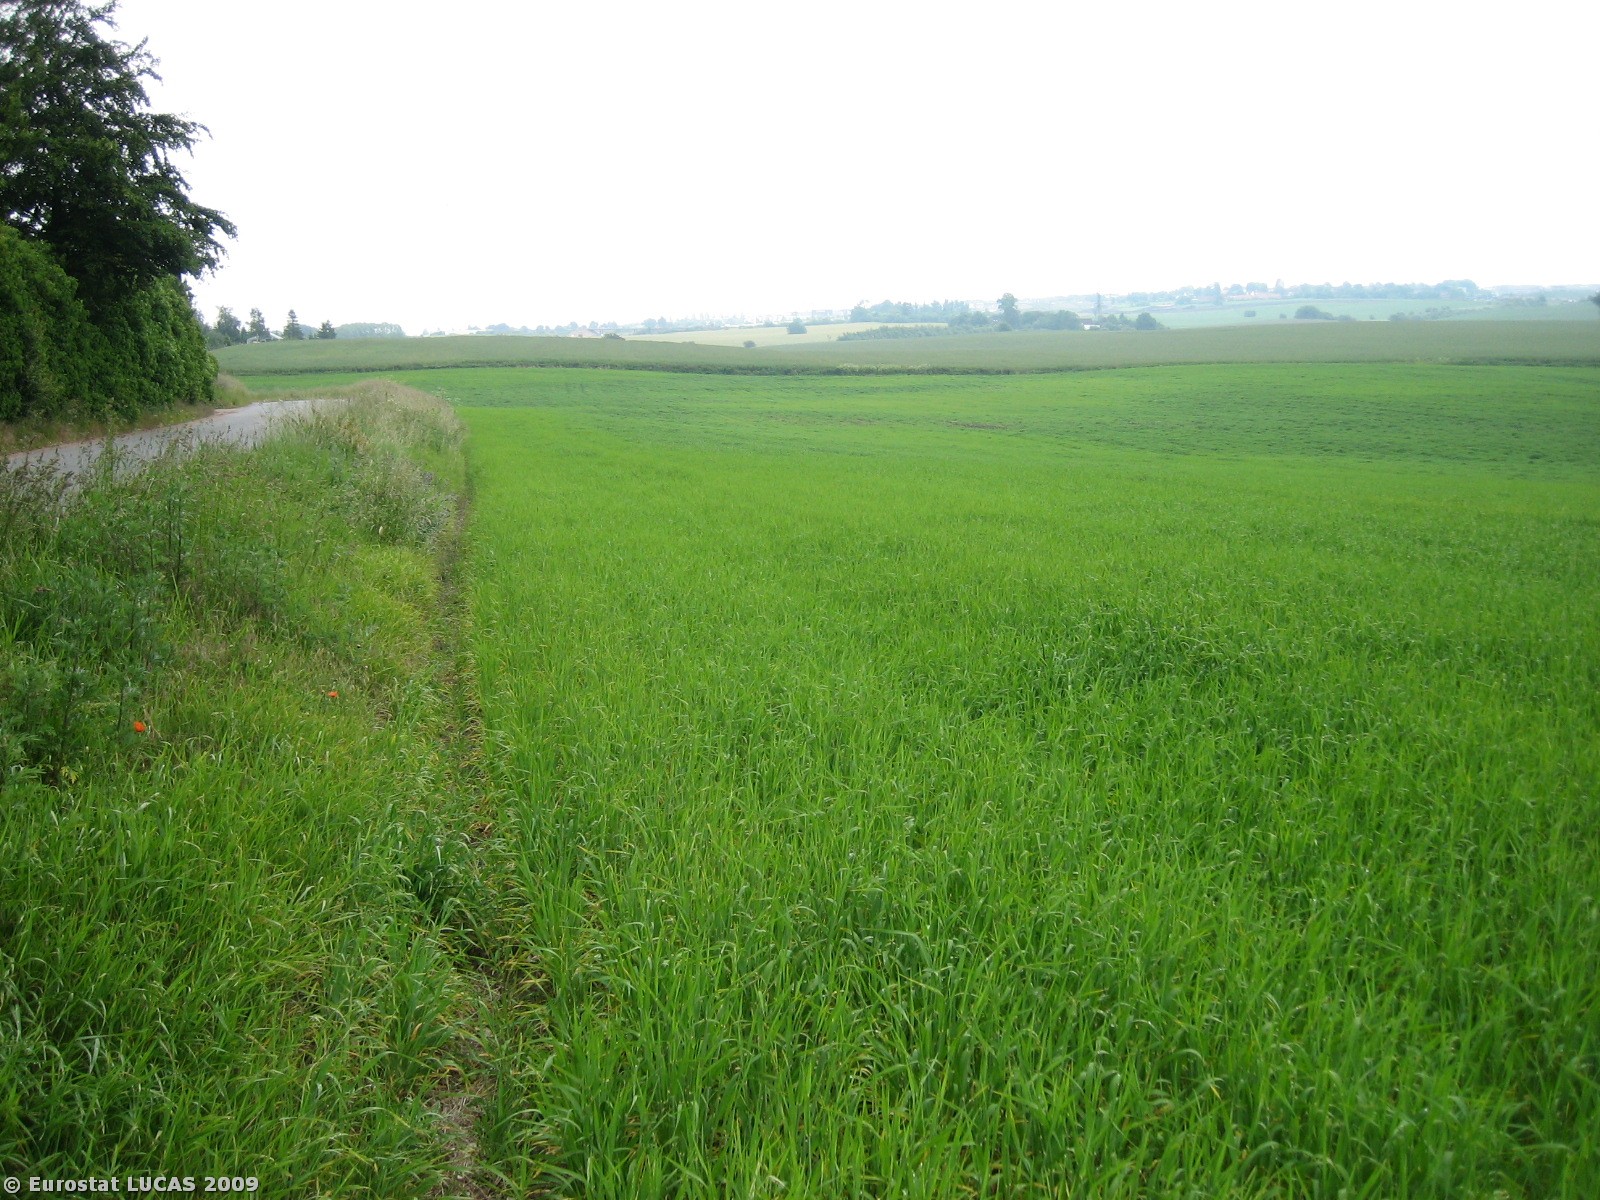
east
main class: Cropland
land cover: Barley
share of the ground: > 75 %
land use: Agriculture (excluding fallow land and kitchen gardens)
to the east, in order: Barley
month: June
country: DK
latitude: 56.2056
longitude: 10.1449
